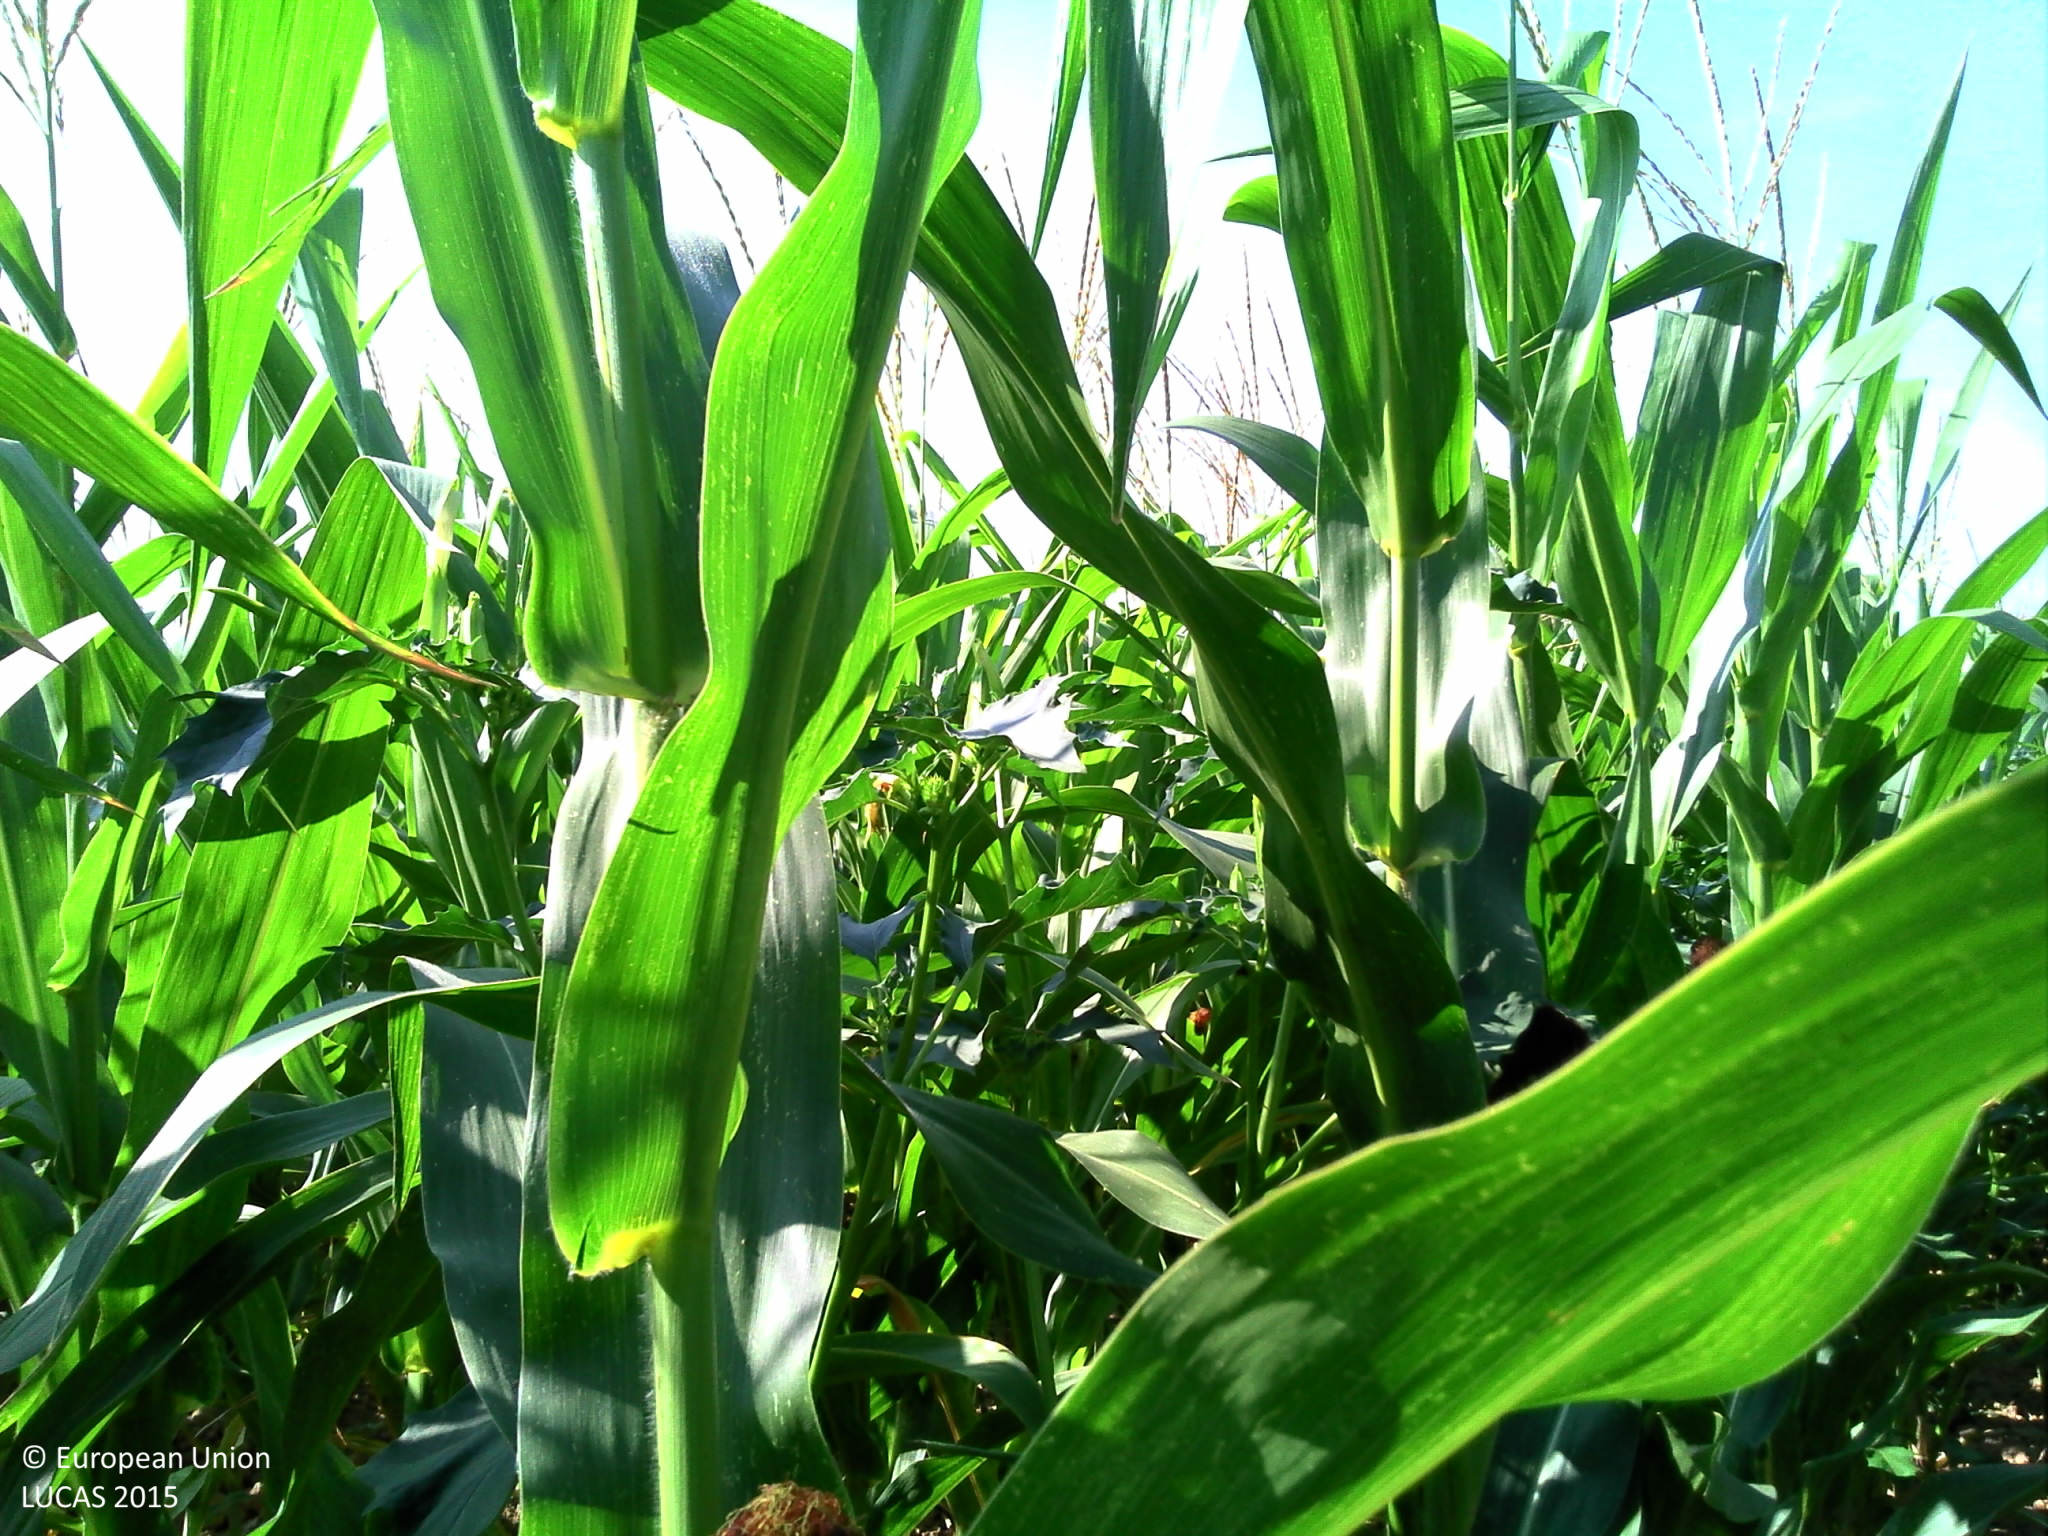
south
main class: Cropland
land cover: Maize
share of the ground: > 75 %
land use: Agriculture (excluding fallow land and kitchen gardens)
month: August
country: FR
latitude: 44.7950
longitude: 1.2352
